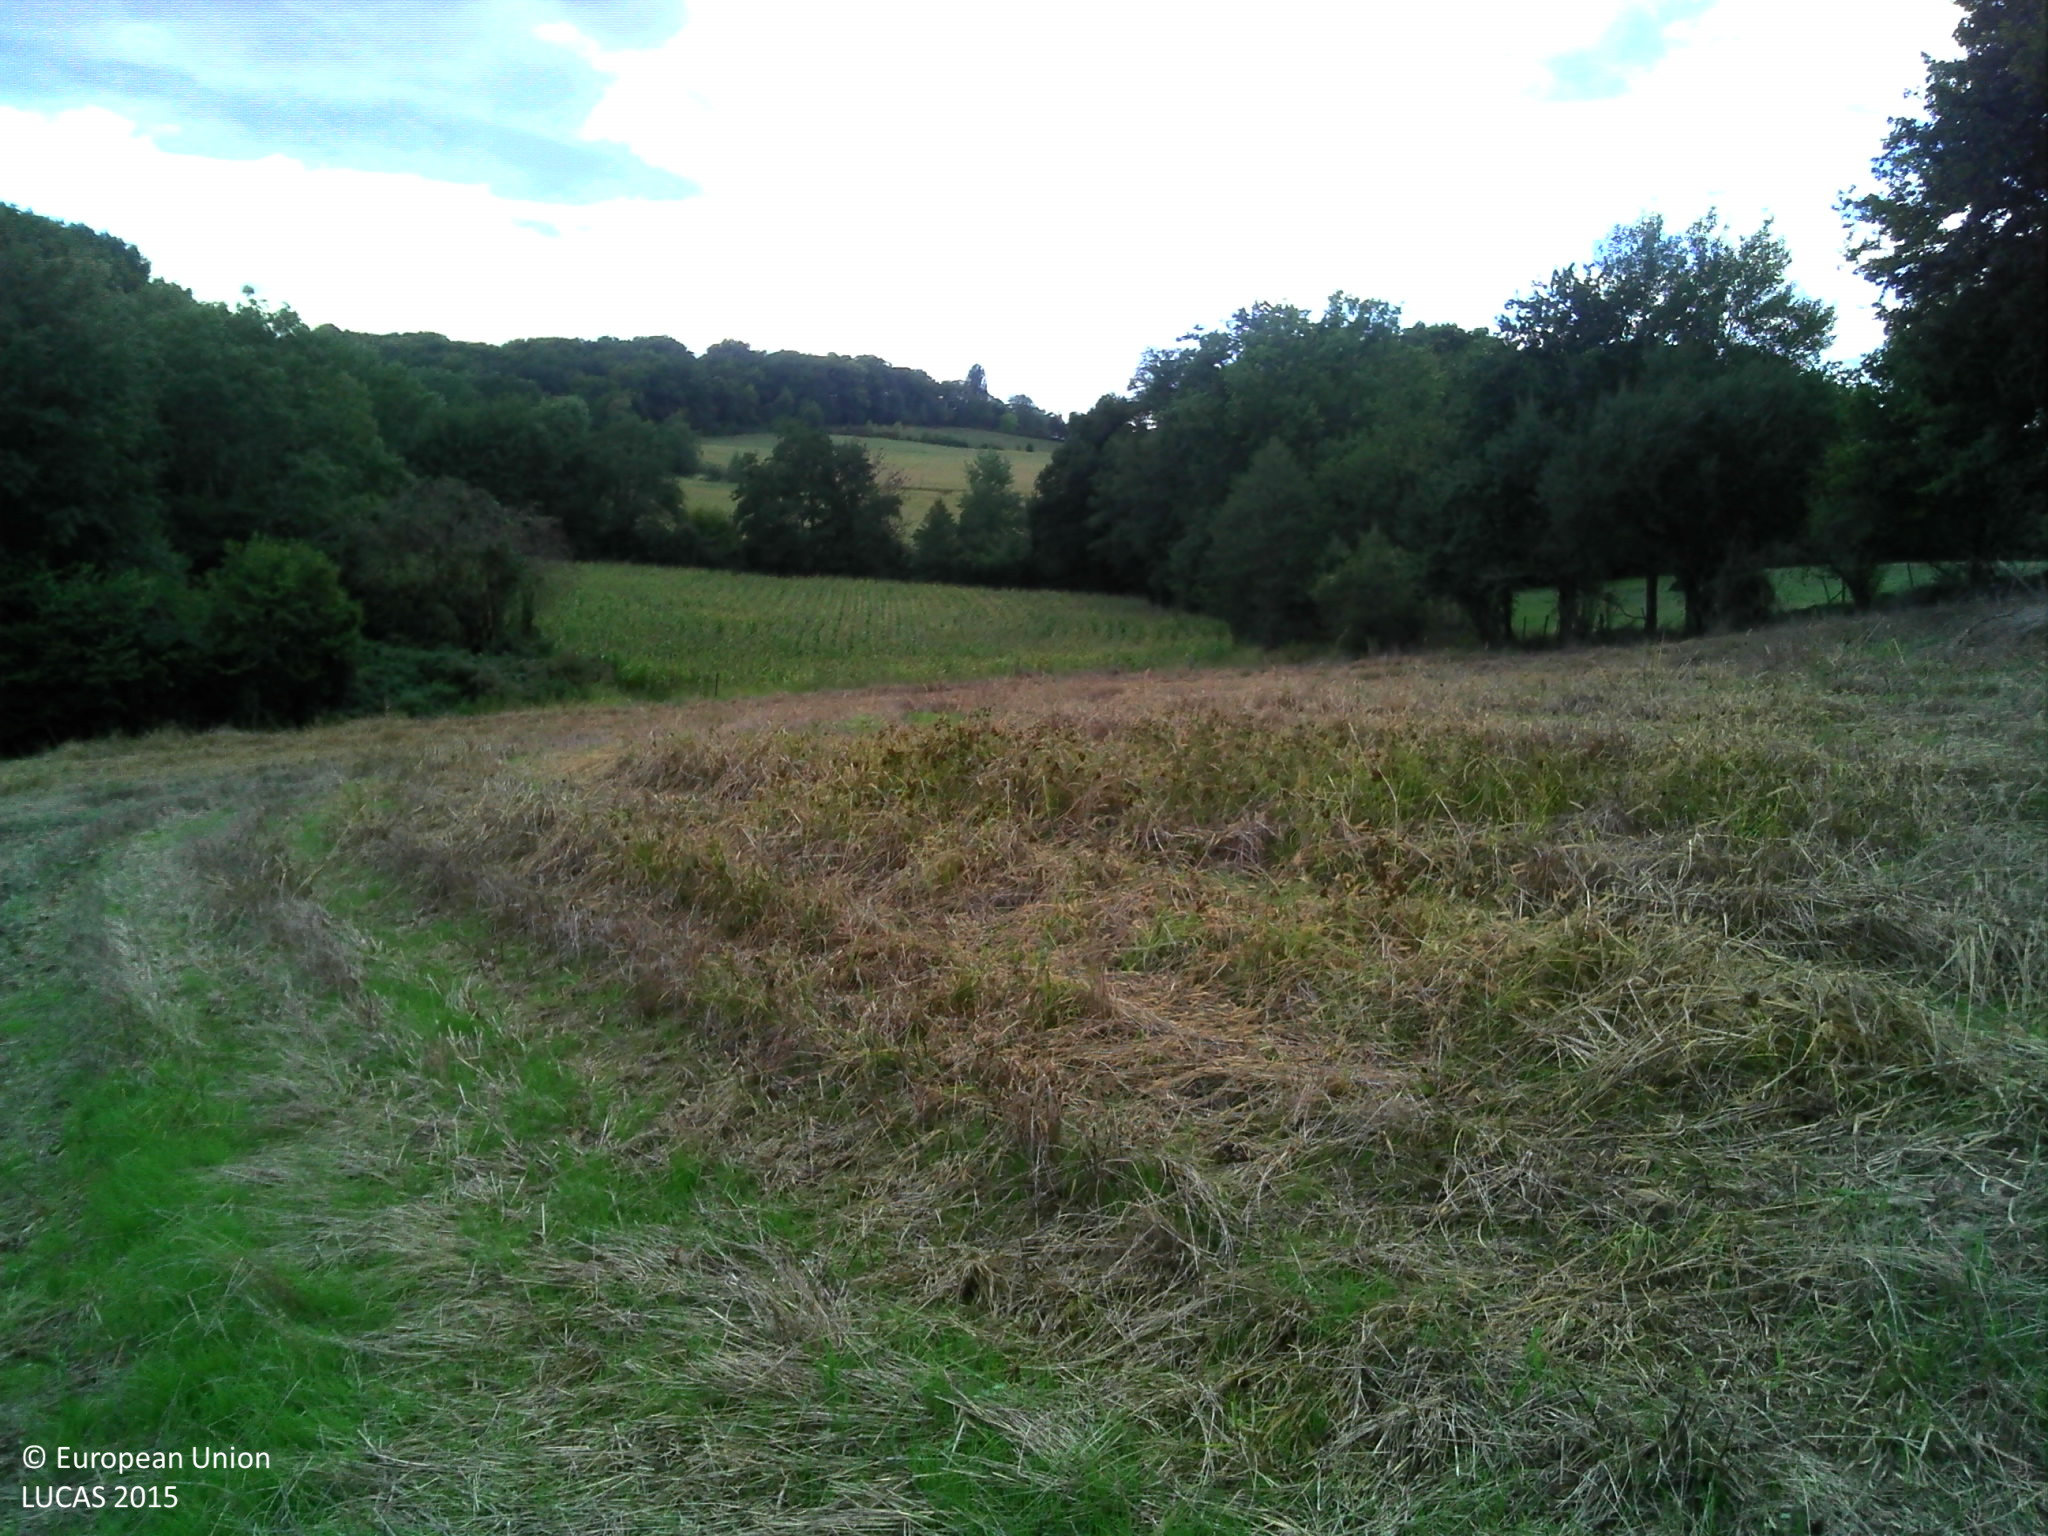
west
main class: Cropland
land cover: Barley
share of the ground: 50 - 75 %
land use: Agriculture (excluding fallow land and kitchen gardens)
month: September
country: FR
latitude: 43.4146
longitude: -0.6931
